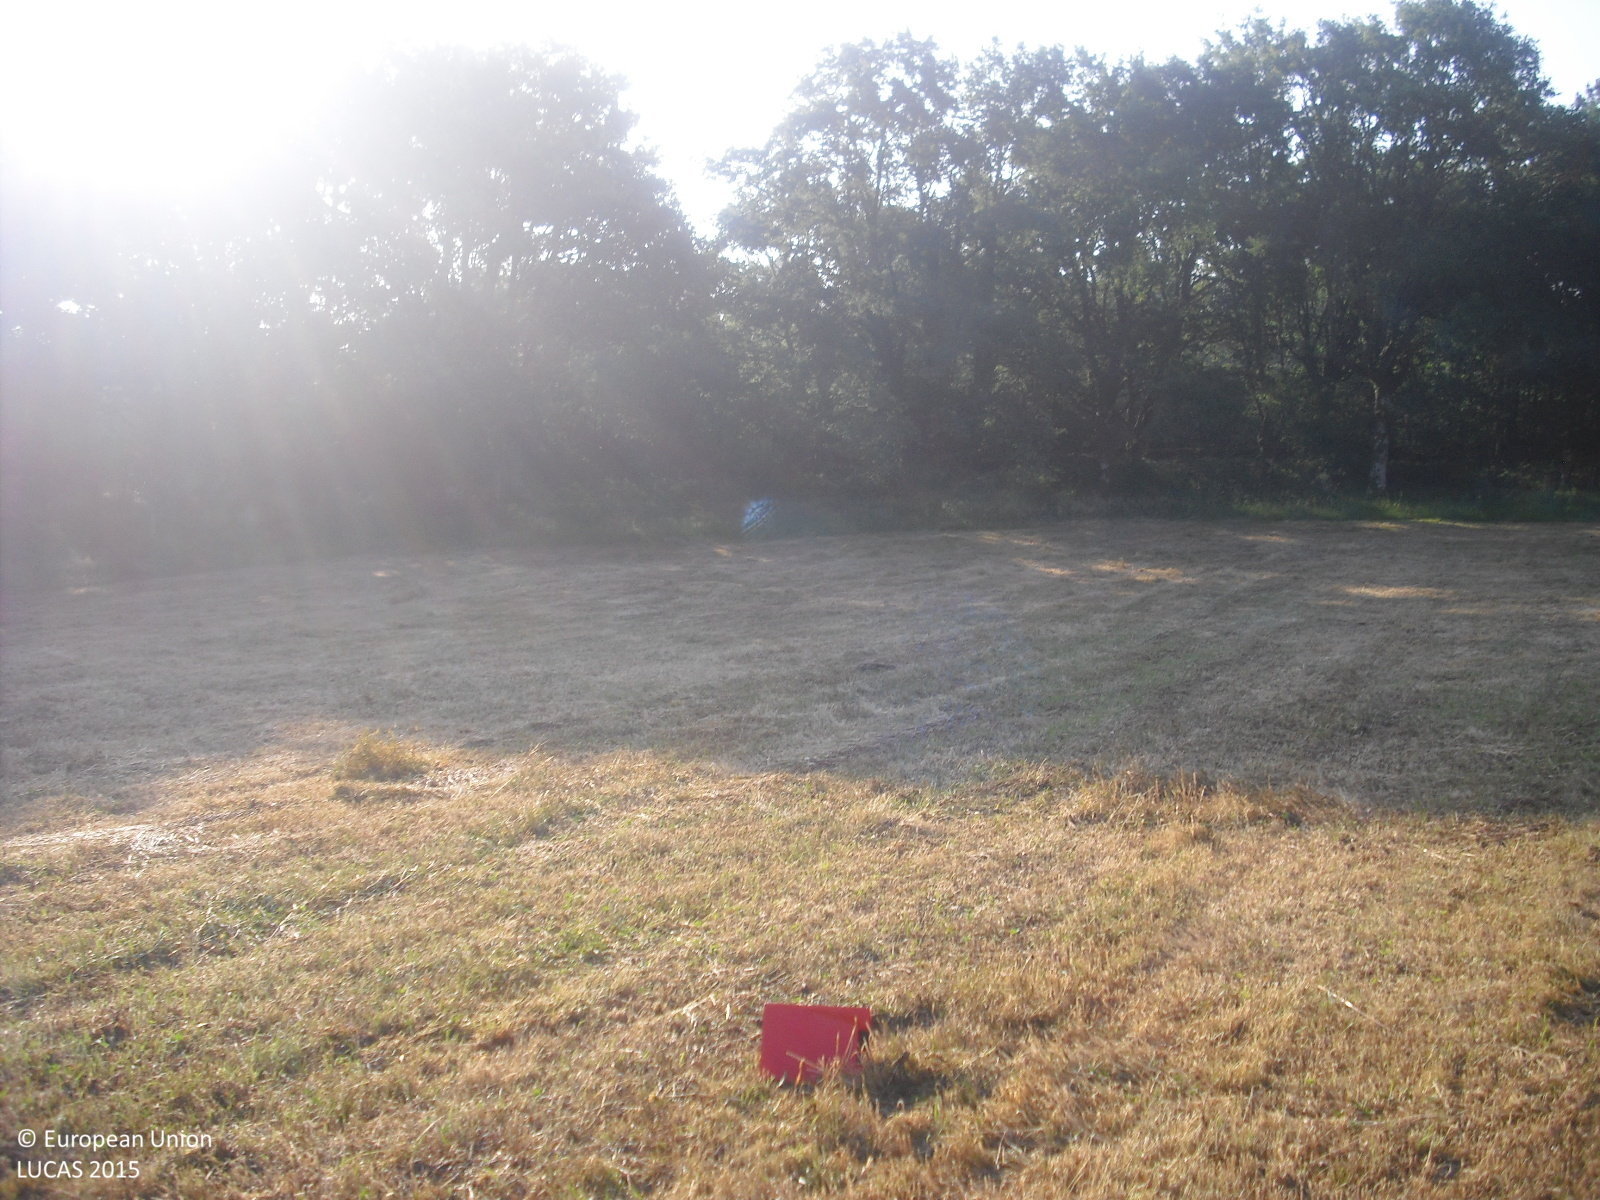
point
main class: Cropland
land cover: Temporary grasslands
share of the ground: > 75 %
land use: Agriculture (excluding fallow land and kitchen gardens)
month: June
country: ES
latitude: 42.5391
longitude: -7.7941
